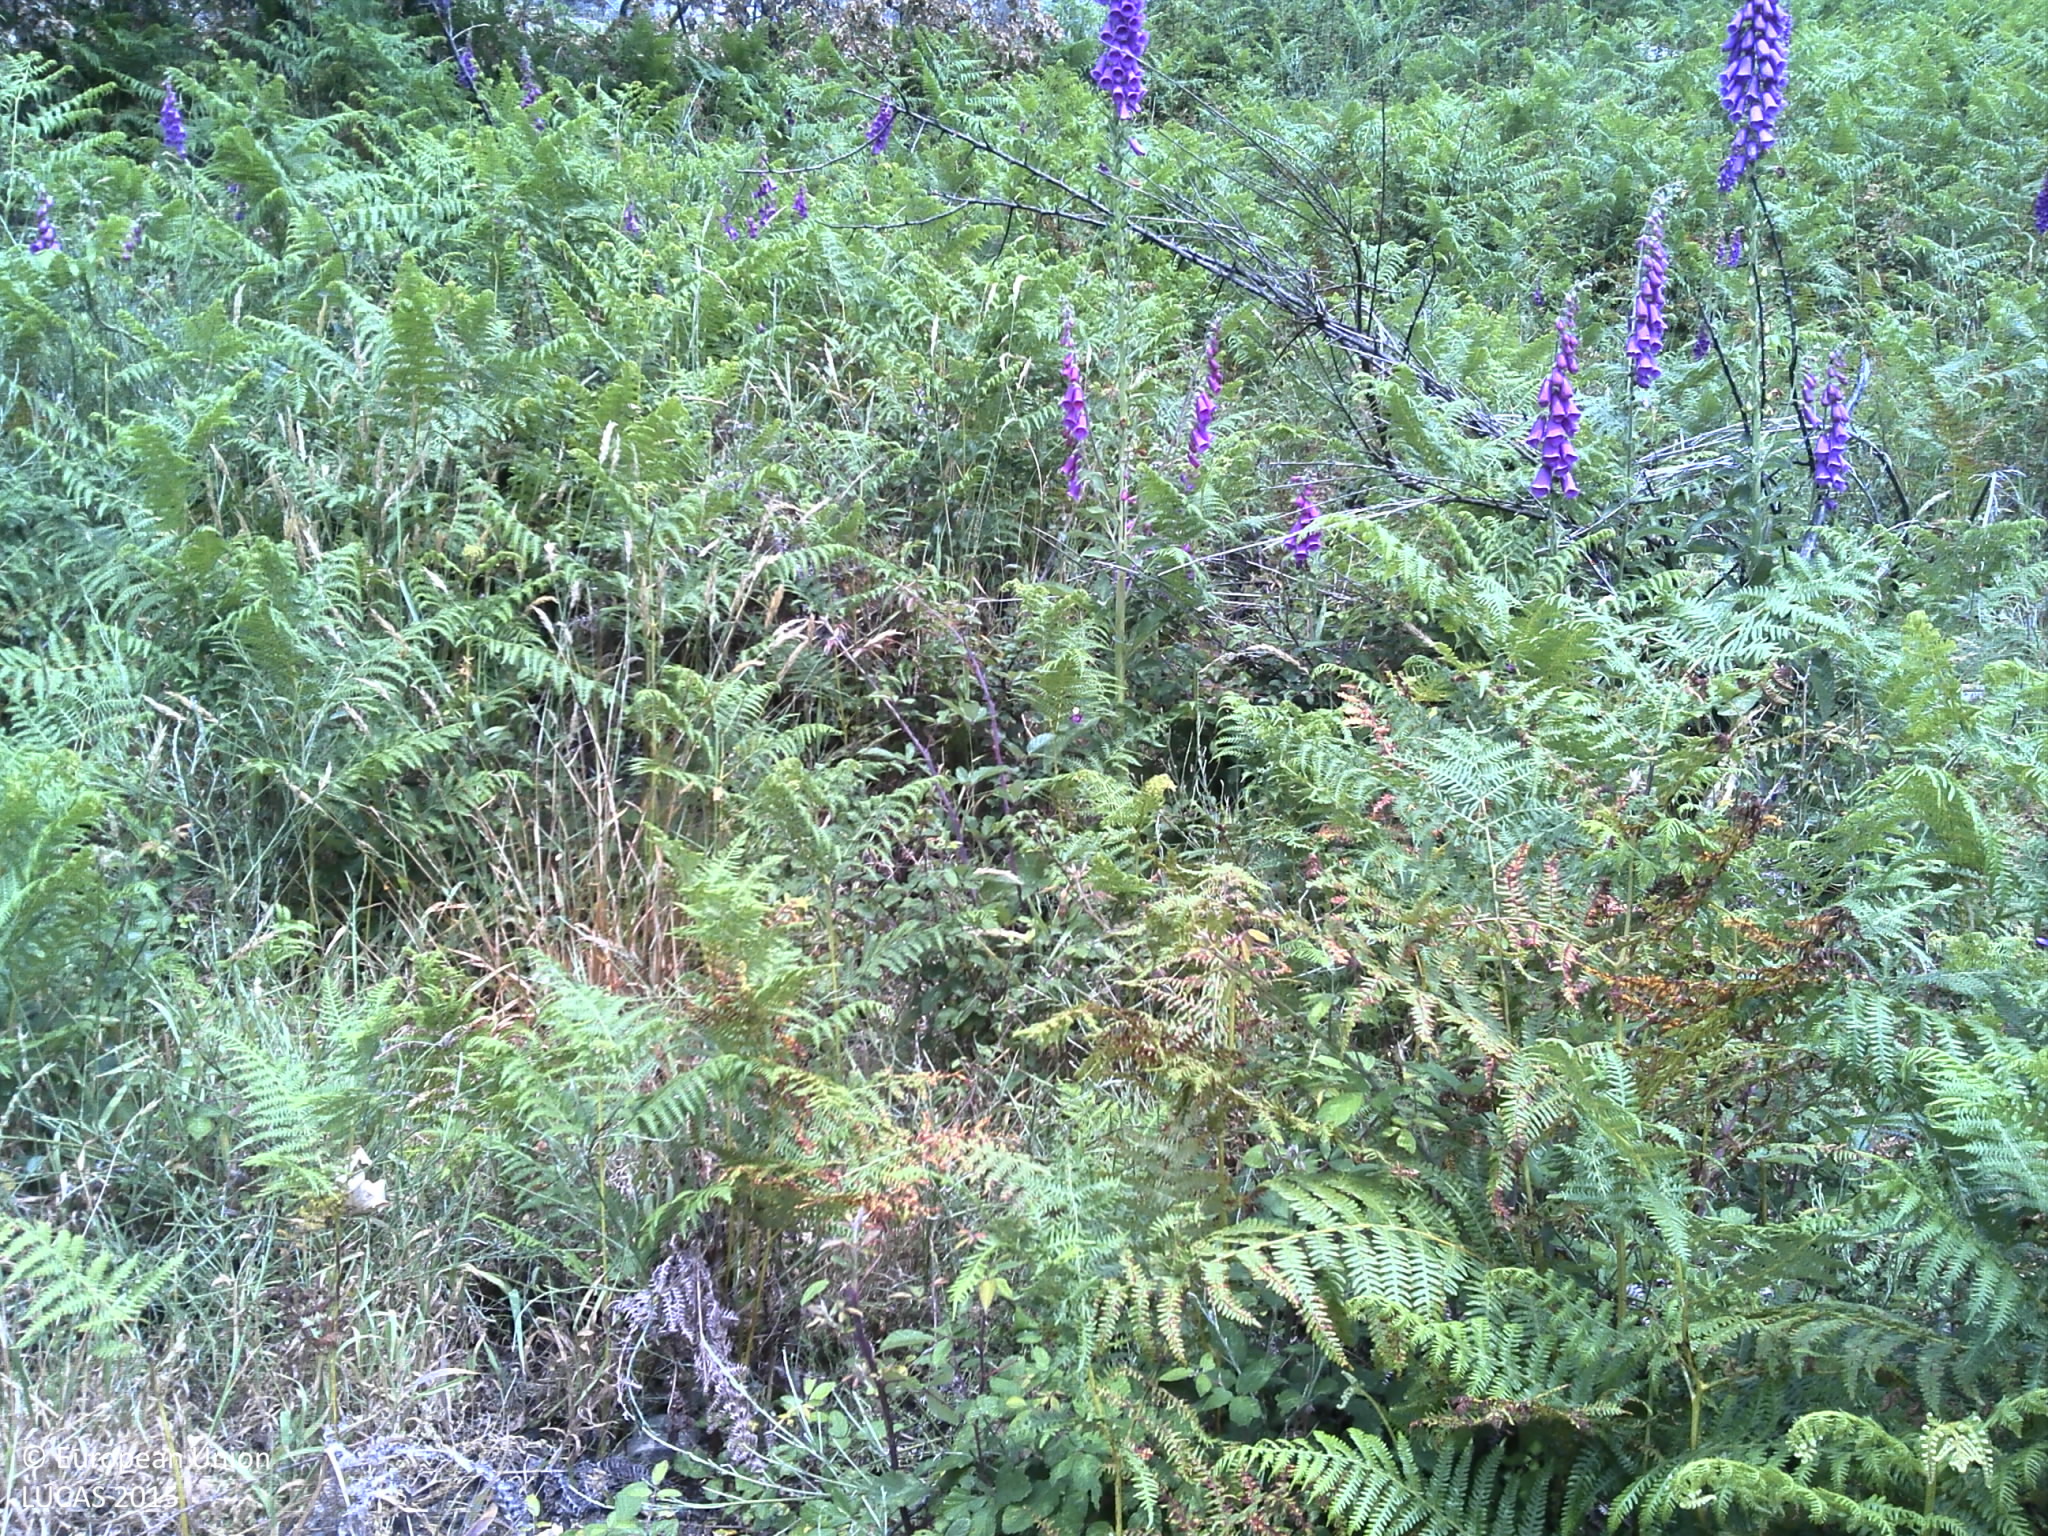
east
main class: Shrubland
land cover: Shrubland without tree cover
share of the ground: 50 - 75 %
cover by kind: shrubs 70 %, herbaceous plants 15 %, consolidated bare surface 10 %, unconsolidated bare surface 5 %
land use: Agriculture (excluding fallow land and kitchen gardens)
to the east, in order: Shrubland without tree cover; Rock outcrops; Shrubland without tree cover; Rock outcrops; Shrubland with sparse tree cover; Shrubland without tree cover; Rock outcrops; Shrubland without tree cover; Electric lines; Shrubland without tree cover; Rocks and stones
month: June
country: PT
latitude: 41.7677
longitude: -8.3802
